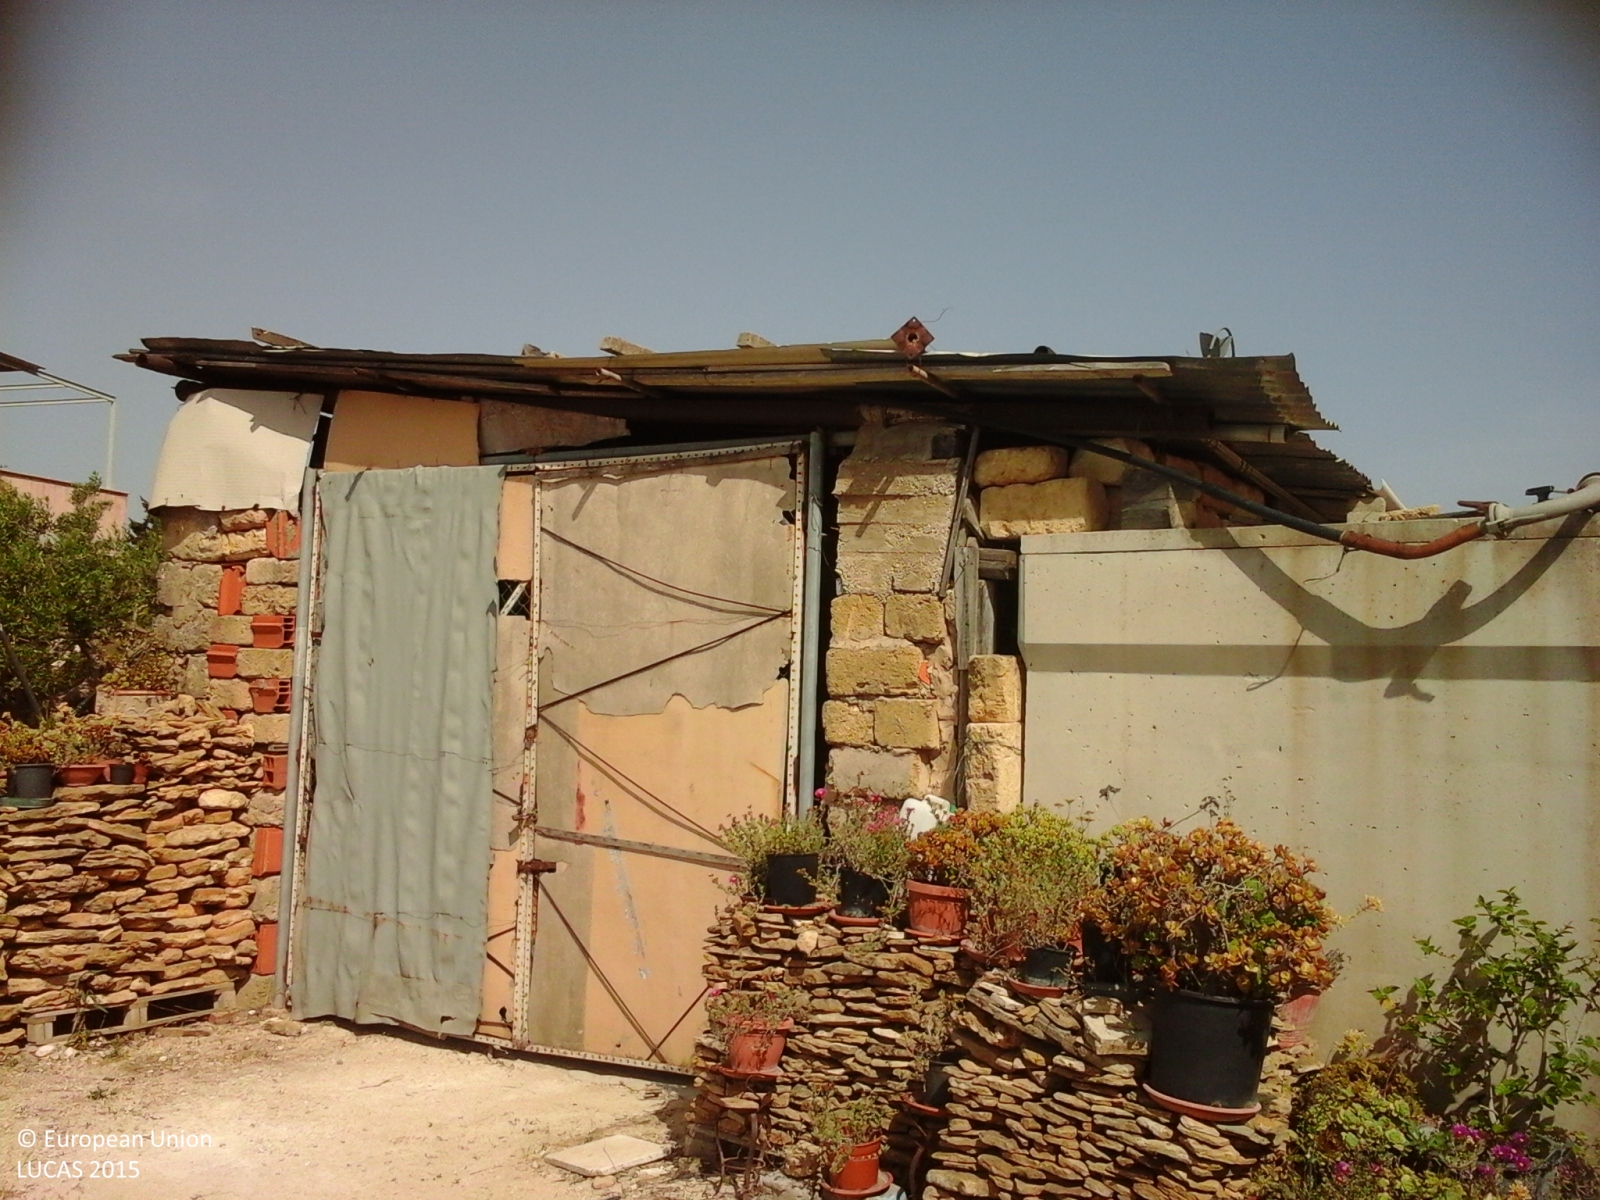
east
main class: Cropland
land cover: Olive groves
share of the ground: 25 - 50 %
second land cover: Other bare soil
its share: > 75 %
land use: Agriculture (excluding fallow land and kitchen gardens)
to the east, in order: Olive groves; Other bare soil; Artificial constructions in urban areas; Other fruit trees and berries; Artificial constructions in urban areas; Other fresh vegetables; Olive groves; Grass margins
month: May
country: IT
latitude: 37.5346
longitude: 13.0660
